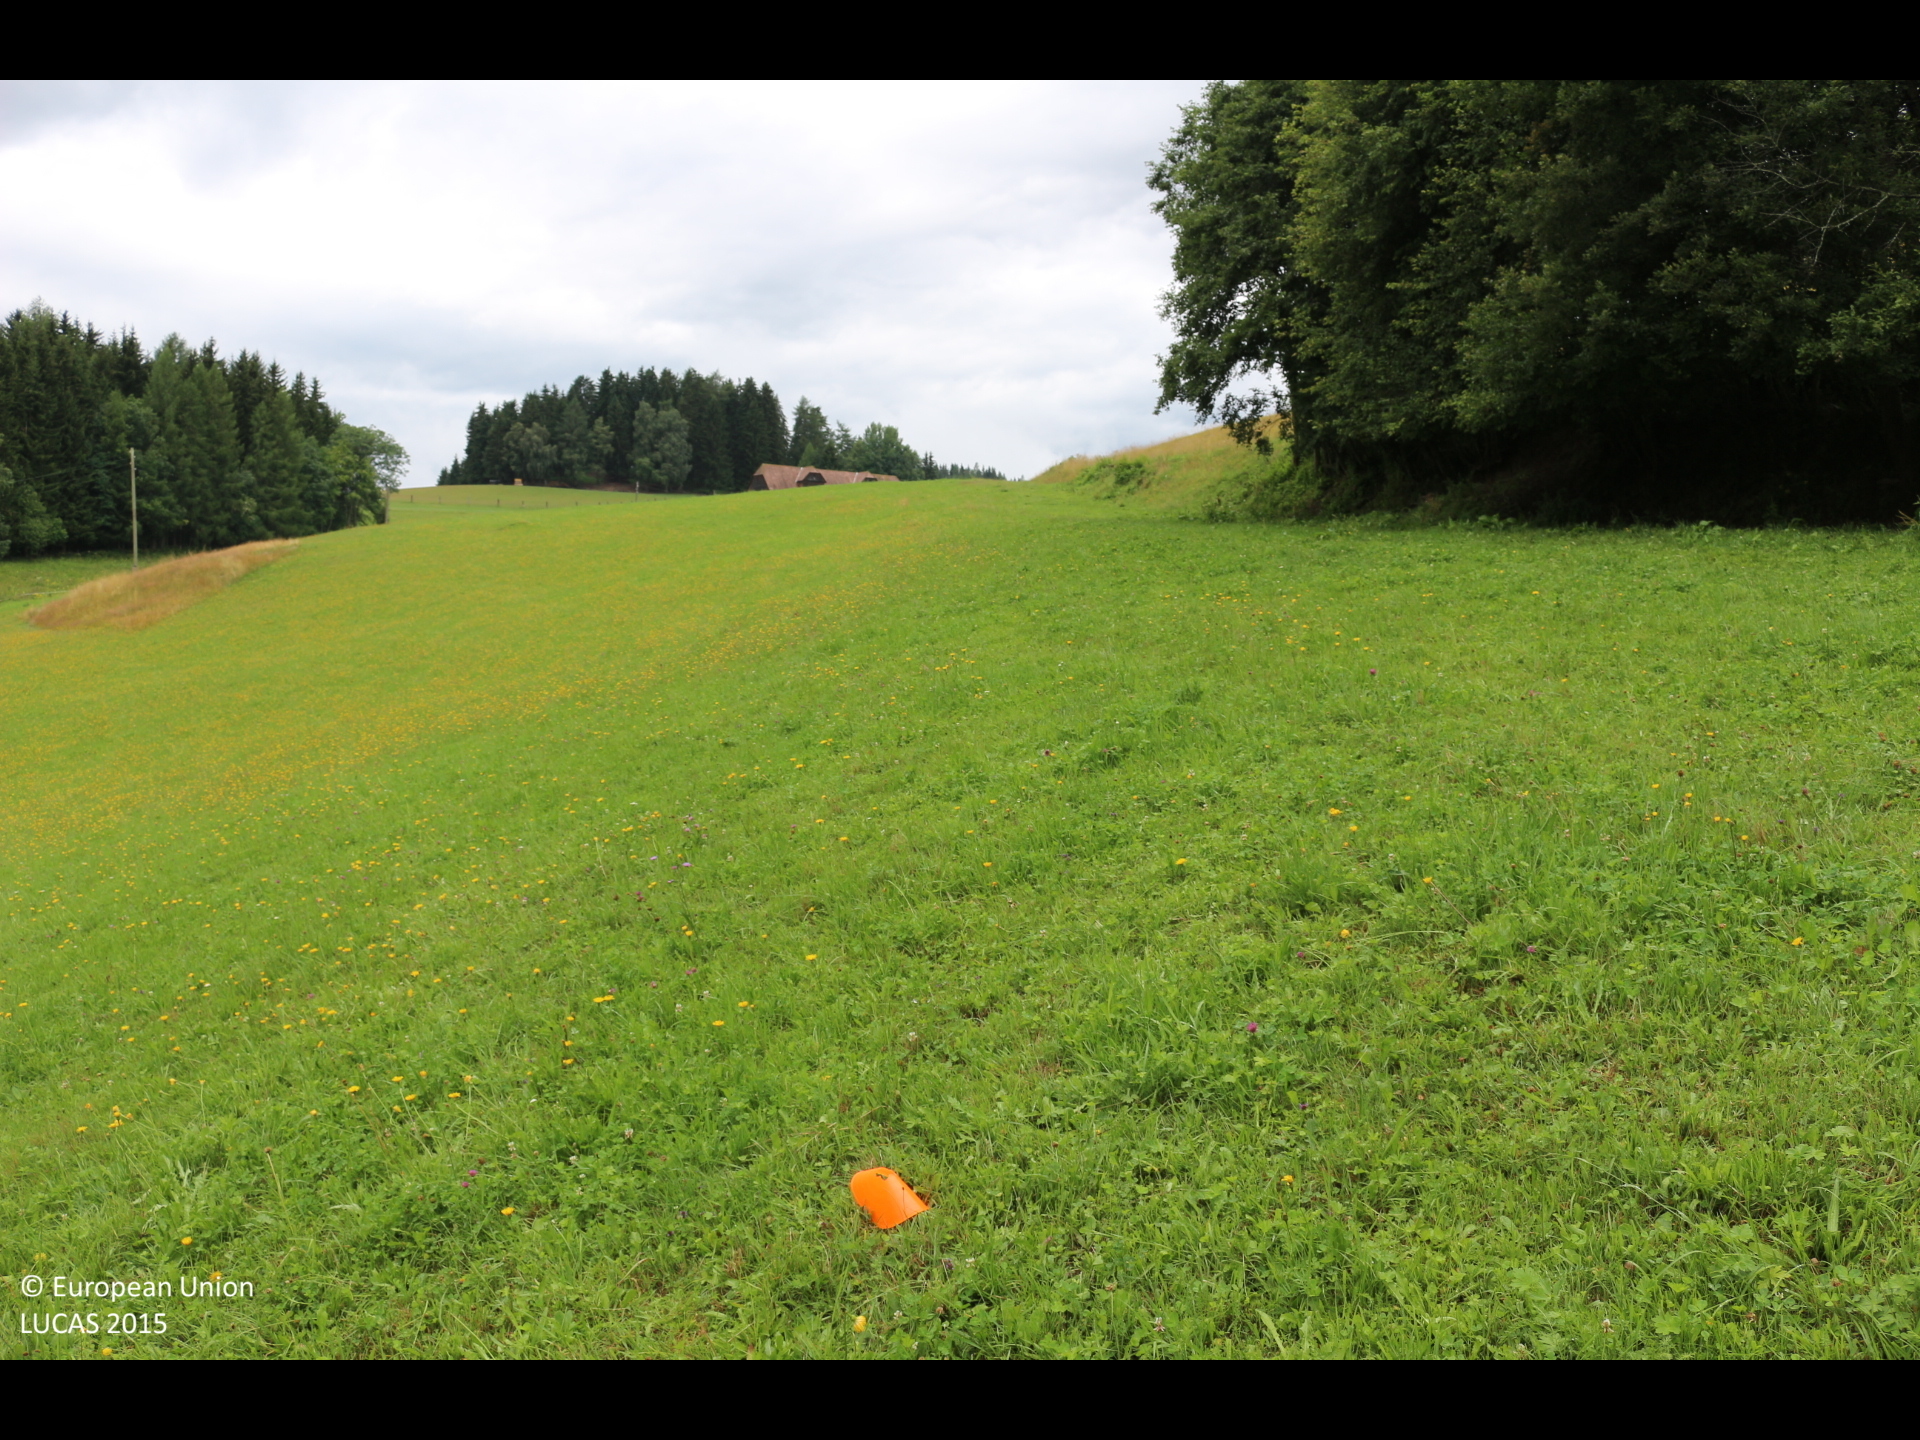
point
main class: Grassland
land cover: Grassland without tree/shrub cover
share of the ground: > 75 %
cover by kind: herbaceous plants 100 %
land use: Agriculture (excluding fallow land and kitchen gardens)
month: July
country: AT
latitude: 46.9608
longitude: 14.4795
